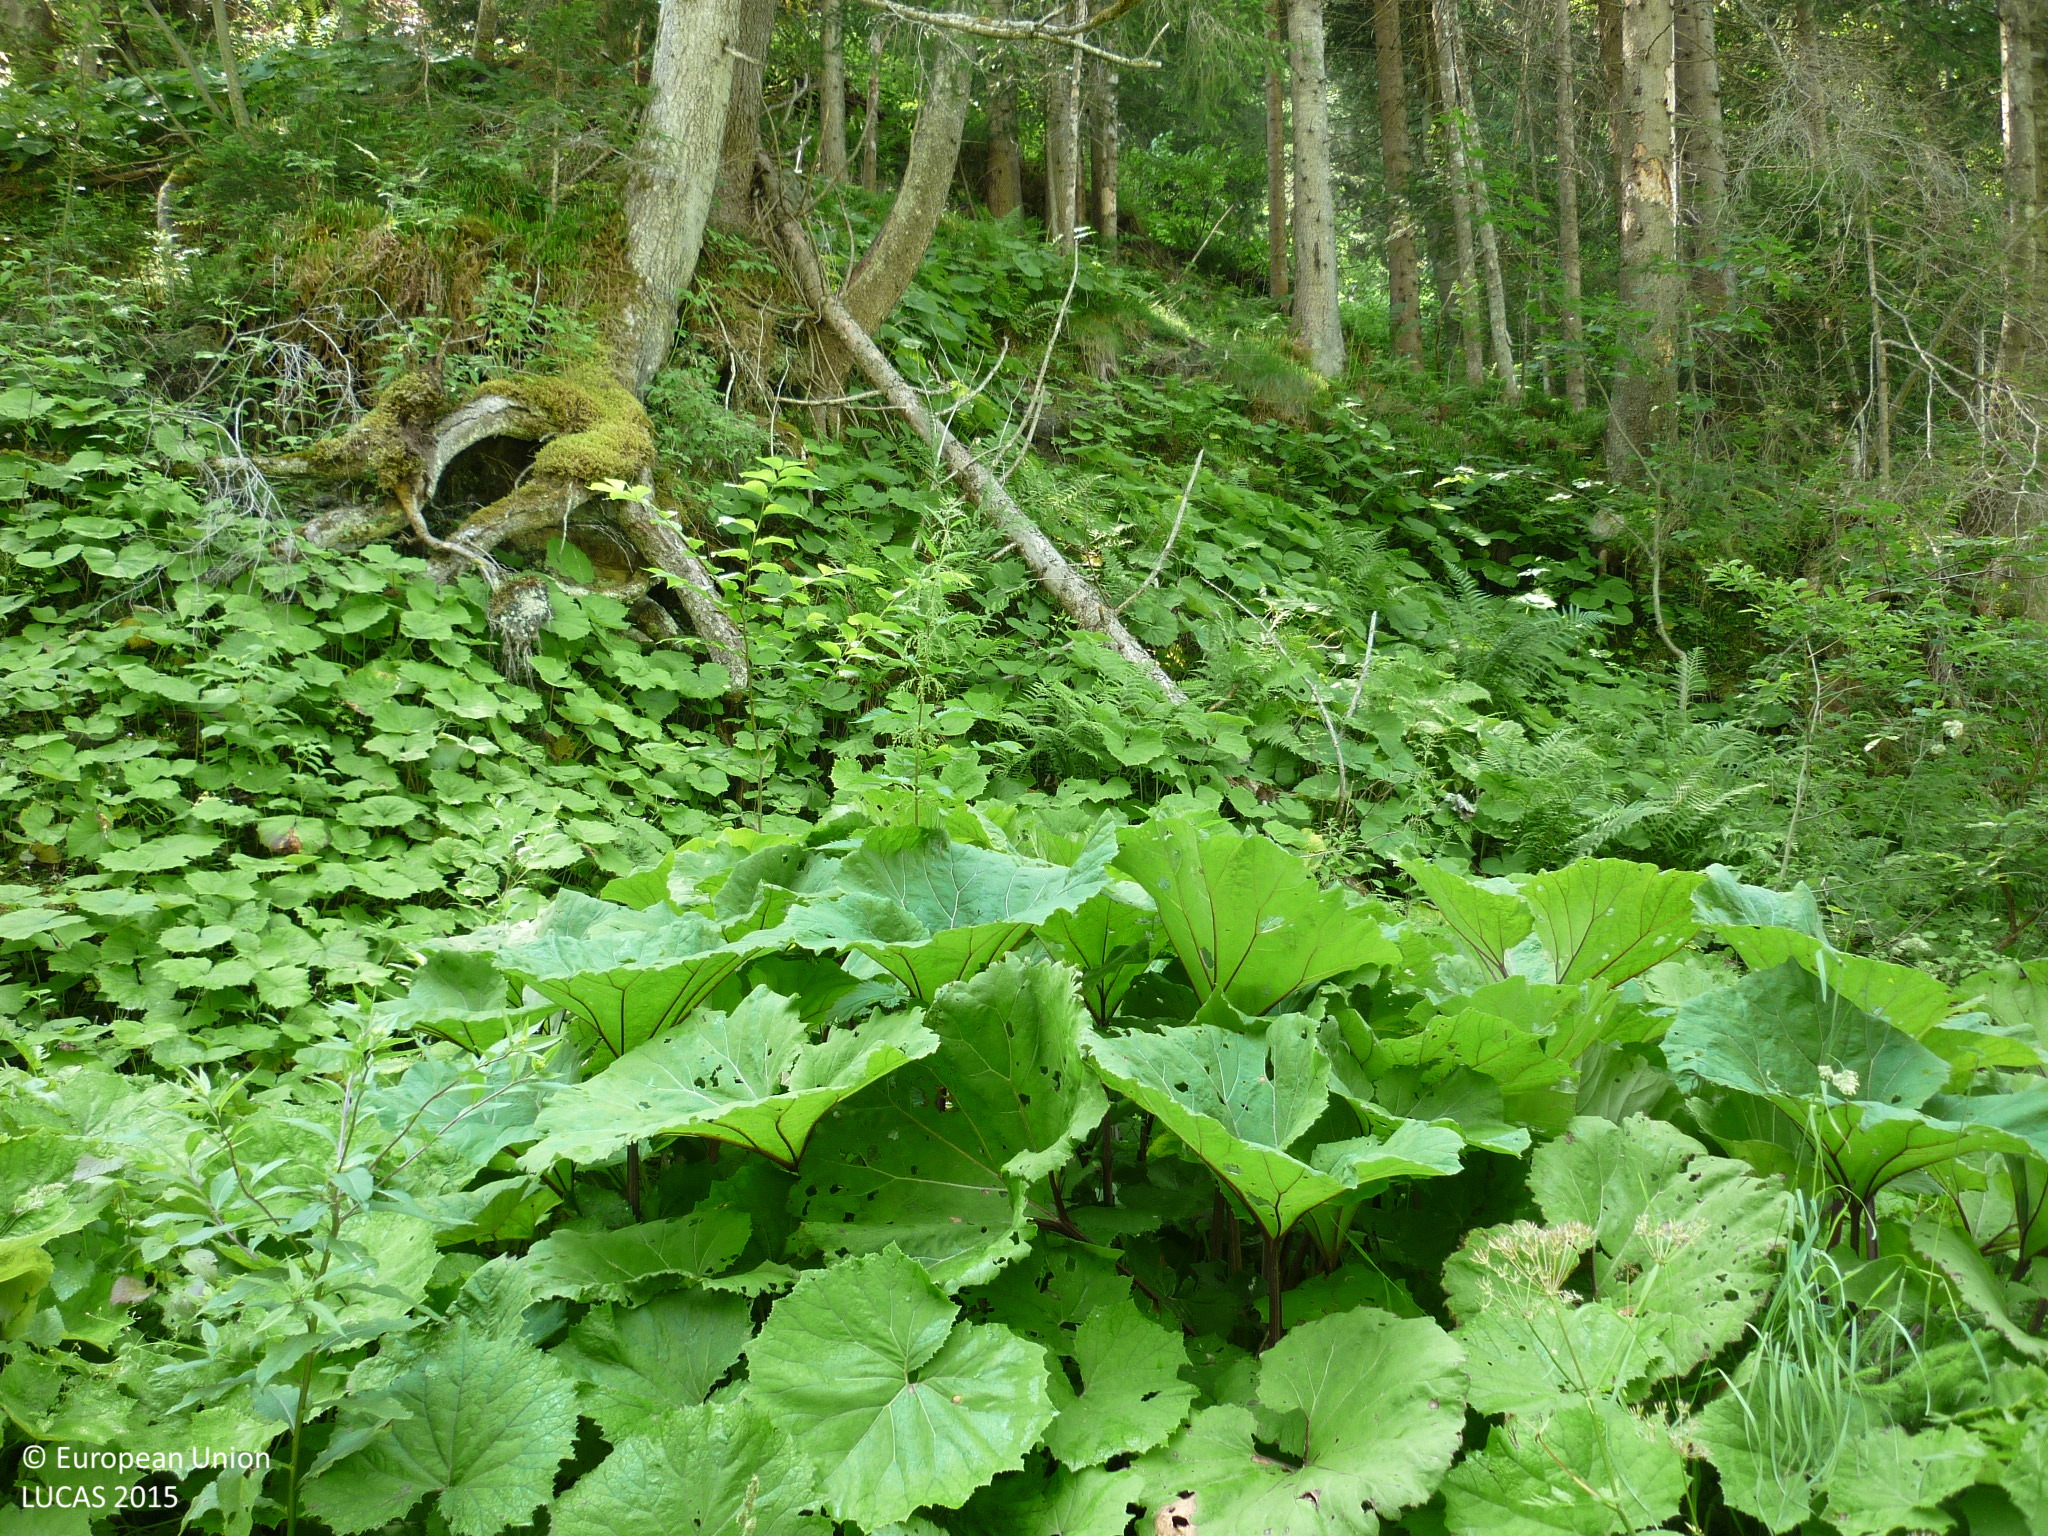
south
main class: Grassland
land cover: Spontaneously vegetated surfaces
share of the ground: > 75 %
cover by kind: herbaceous plants 80 %, unconsolidated bare surface 15 %, shrubs 5 %
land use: Semi-natural and natural areas not in use
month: July
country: AT
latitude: 47.4265
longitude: 13.5909
